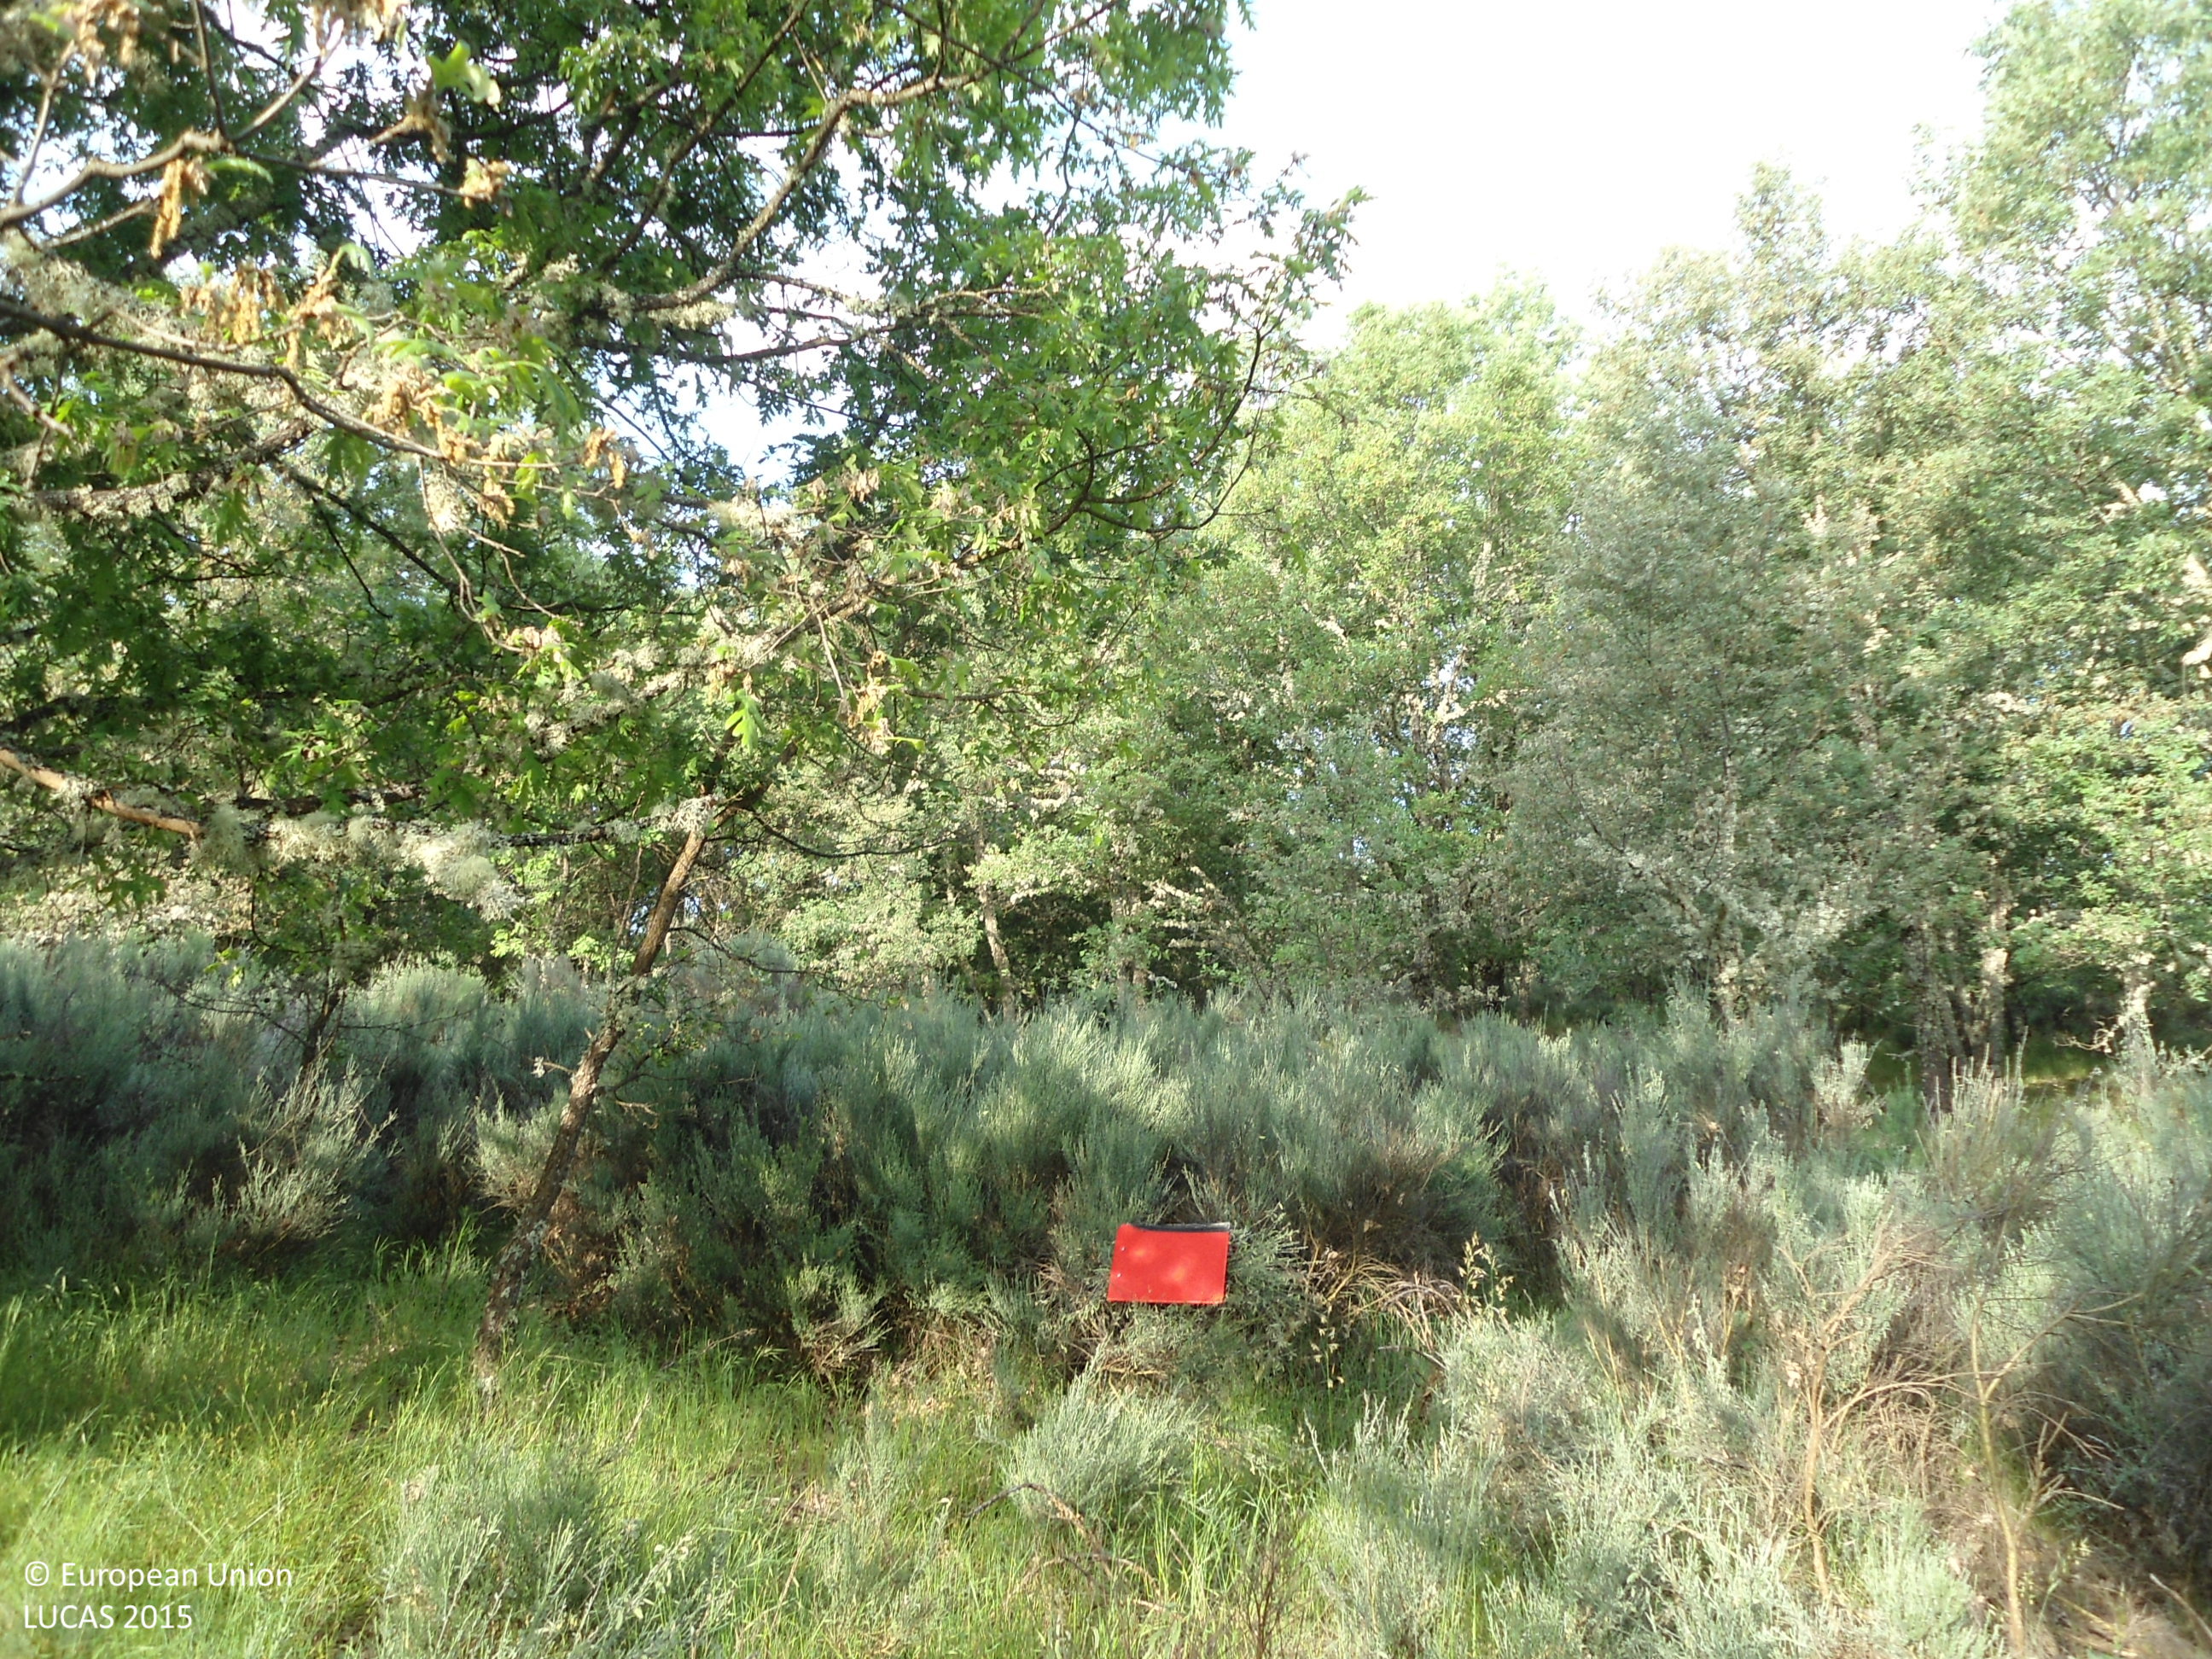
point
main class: Woodland
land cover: Broadleaved woodland
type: broadleaved evergreen forest
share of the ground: > 75 %
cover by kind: broadleaved forest trees 75 %, shrubs 20 %, herbaceous plants 5 %
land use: Forestry
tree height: > 5 m
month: June
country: ES
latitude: 42.0627
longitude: -6.6088
